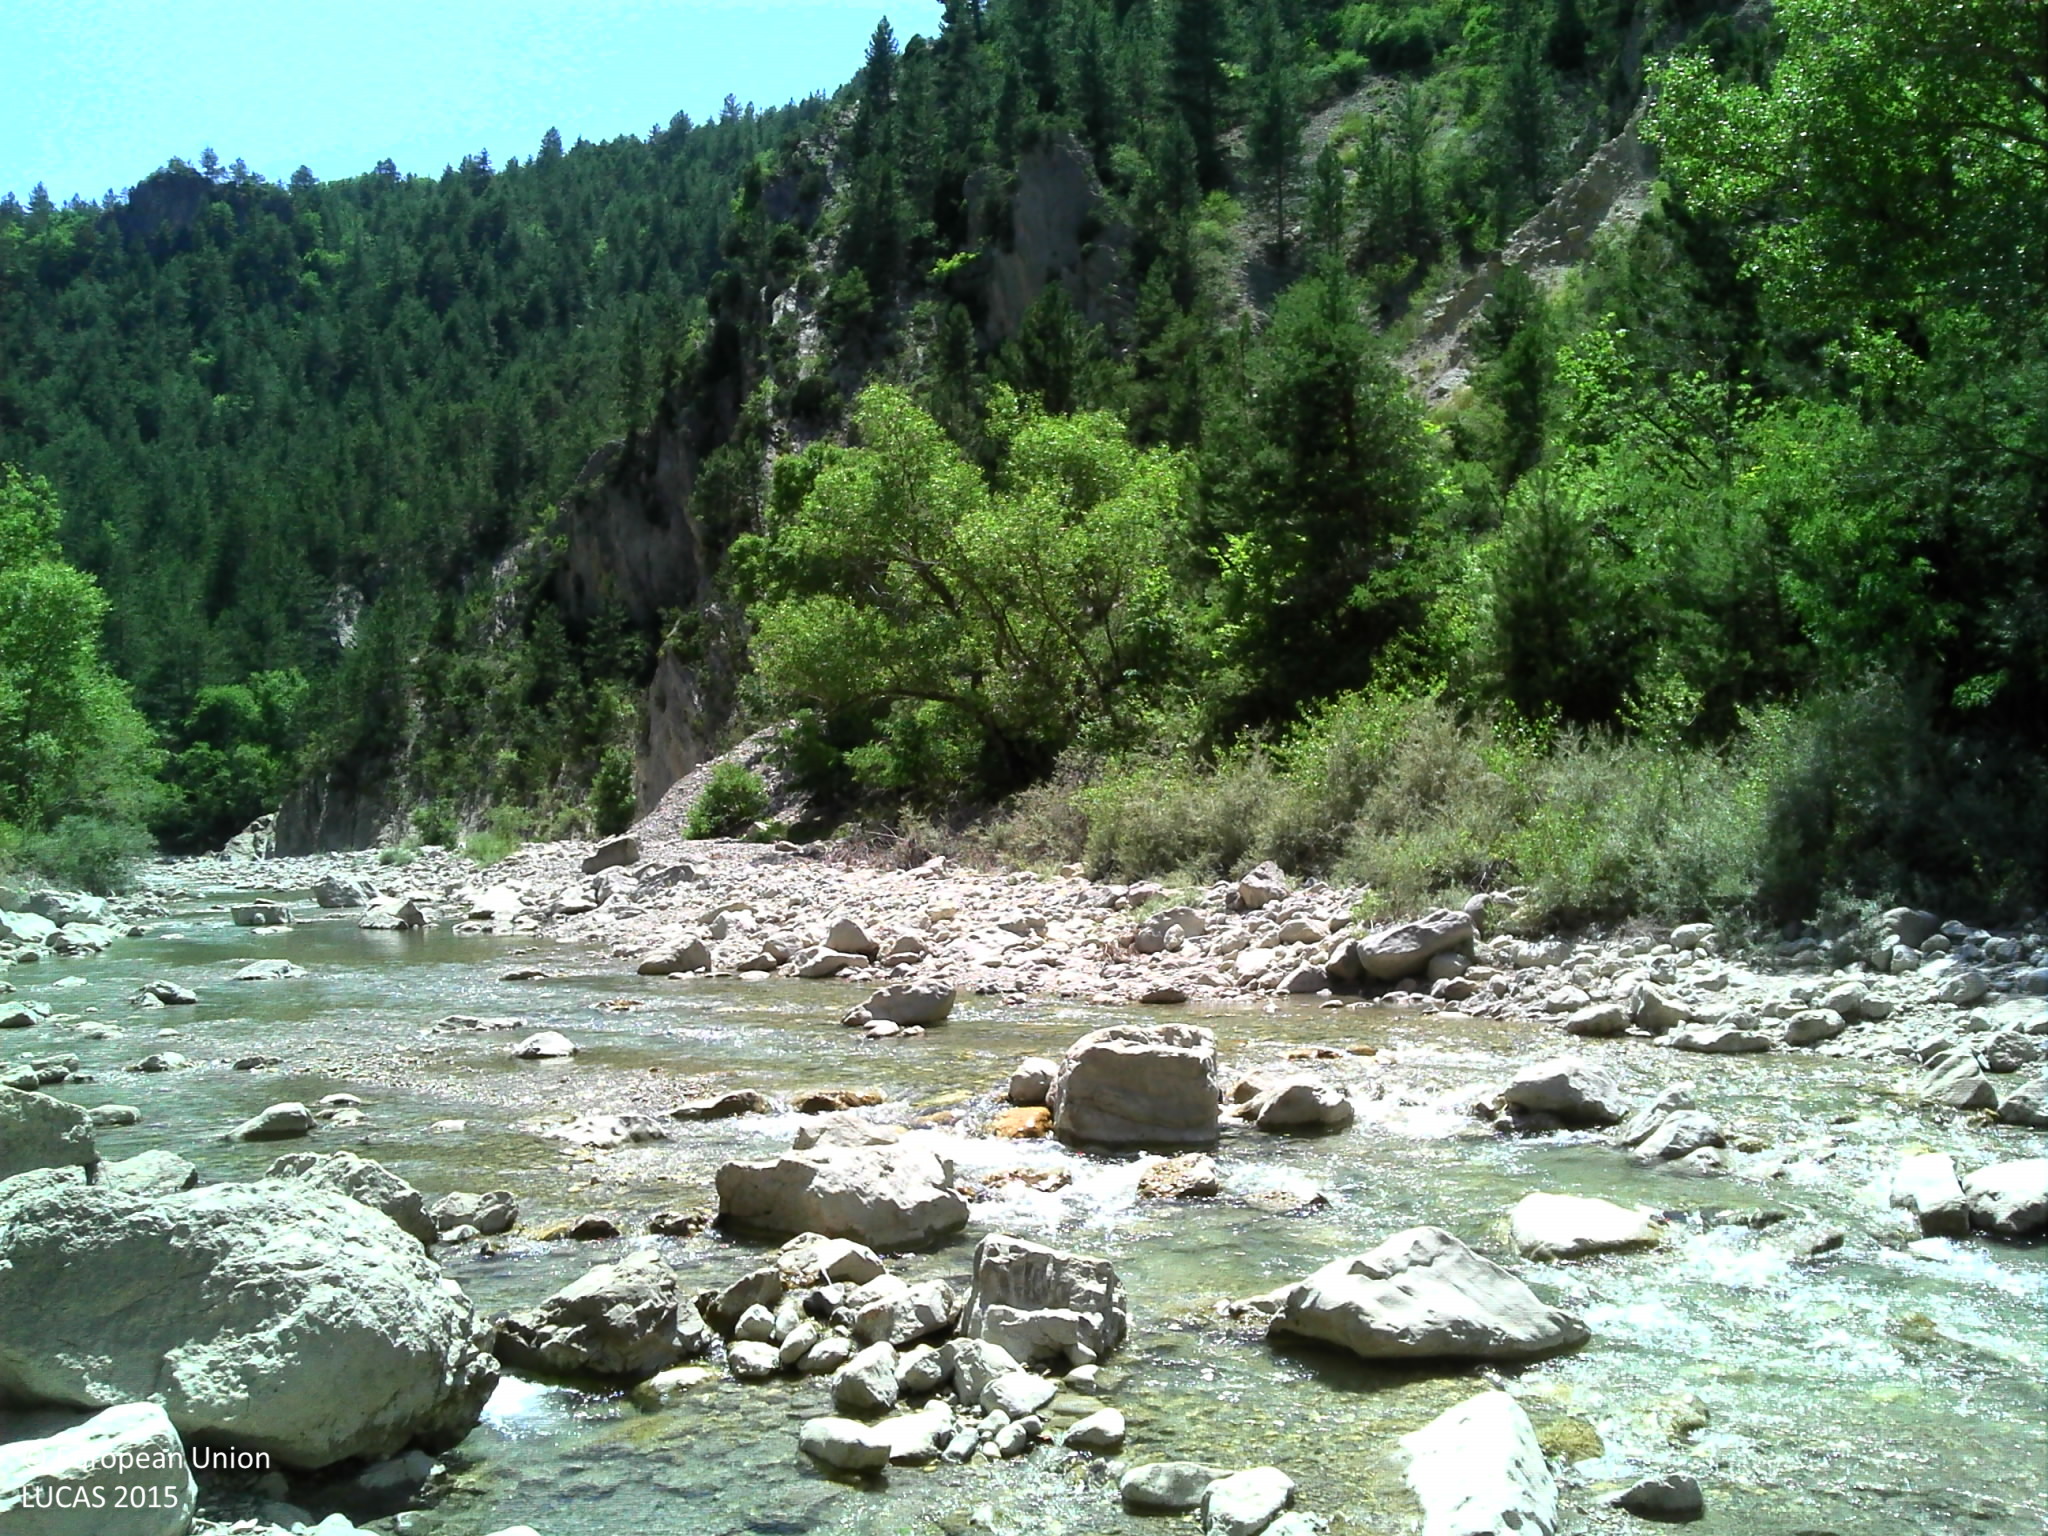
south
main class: Woodland
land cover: Broadleaved woodland
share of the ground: 50 - 75 %
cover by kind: unconsolidated bare surface 50 %, broadleaved forest trees 40 %, herbaceous plants 10 %
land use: Semi-natural and natural areas not in use
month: July
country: FR
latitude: 44.0121
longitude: 6.2532
